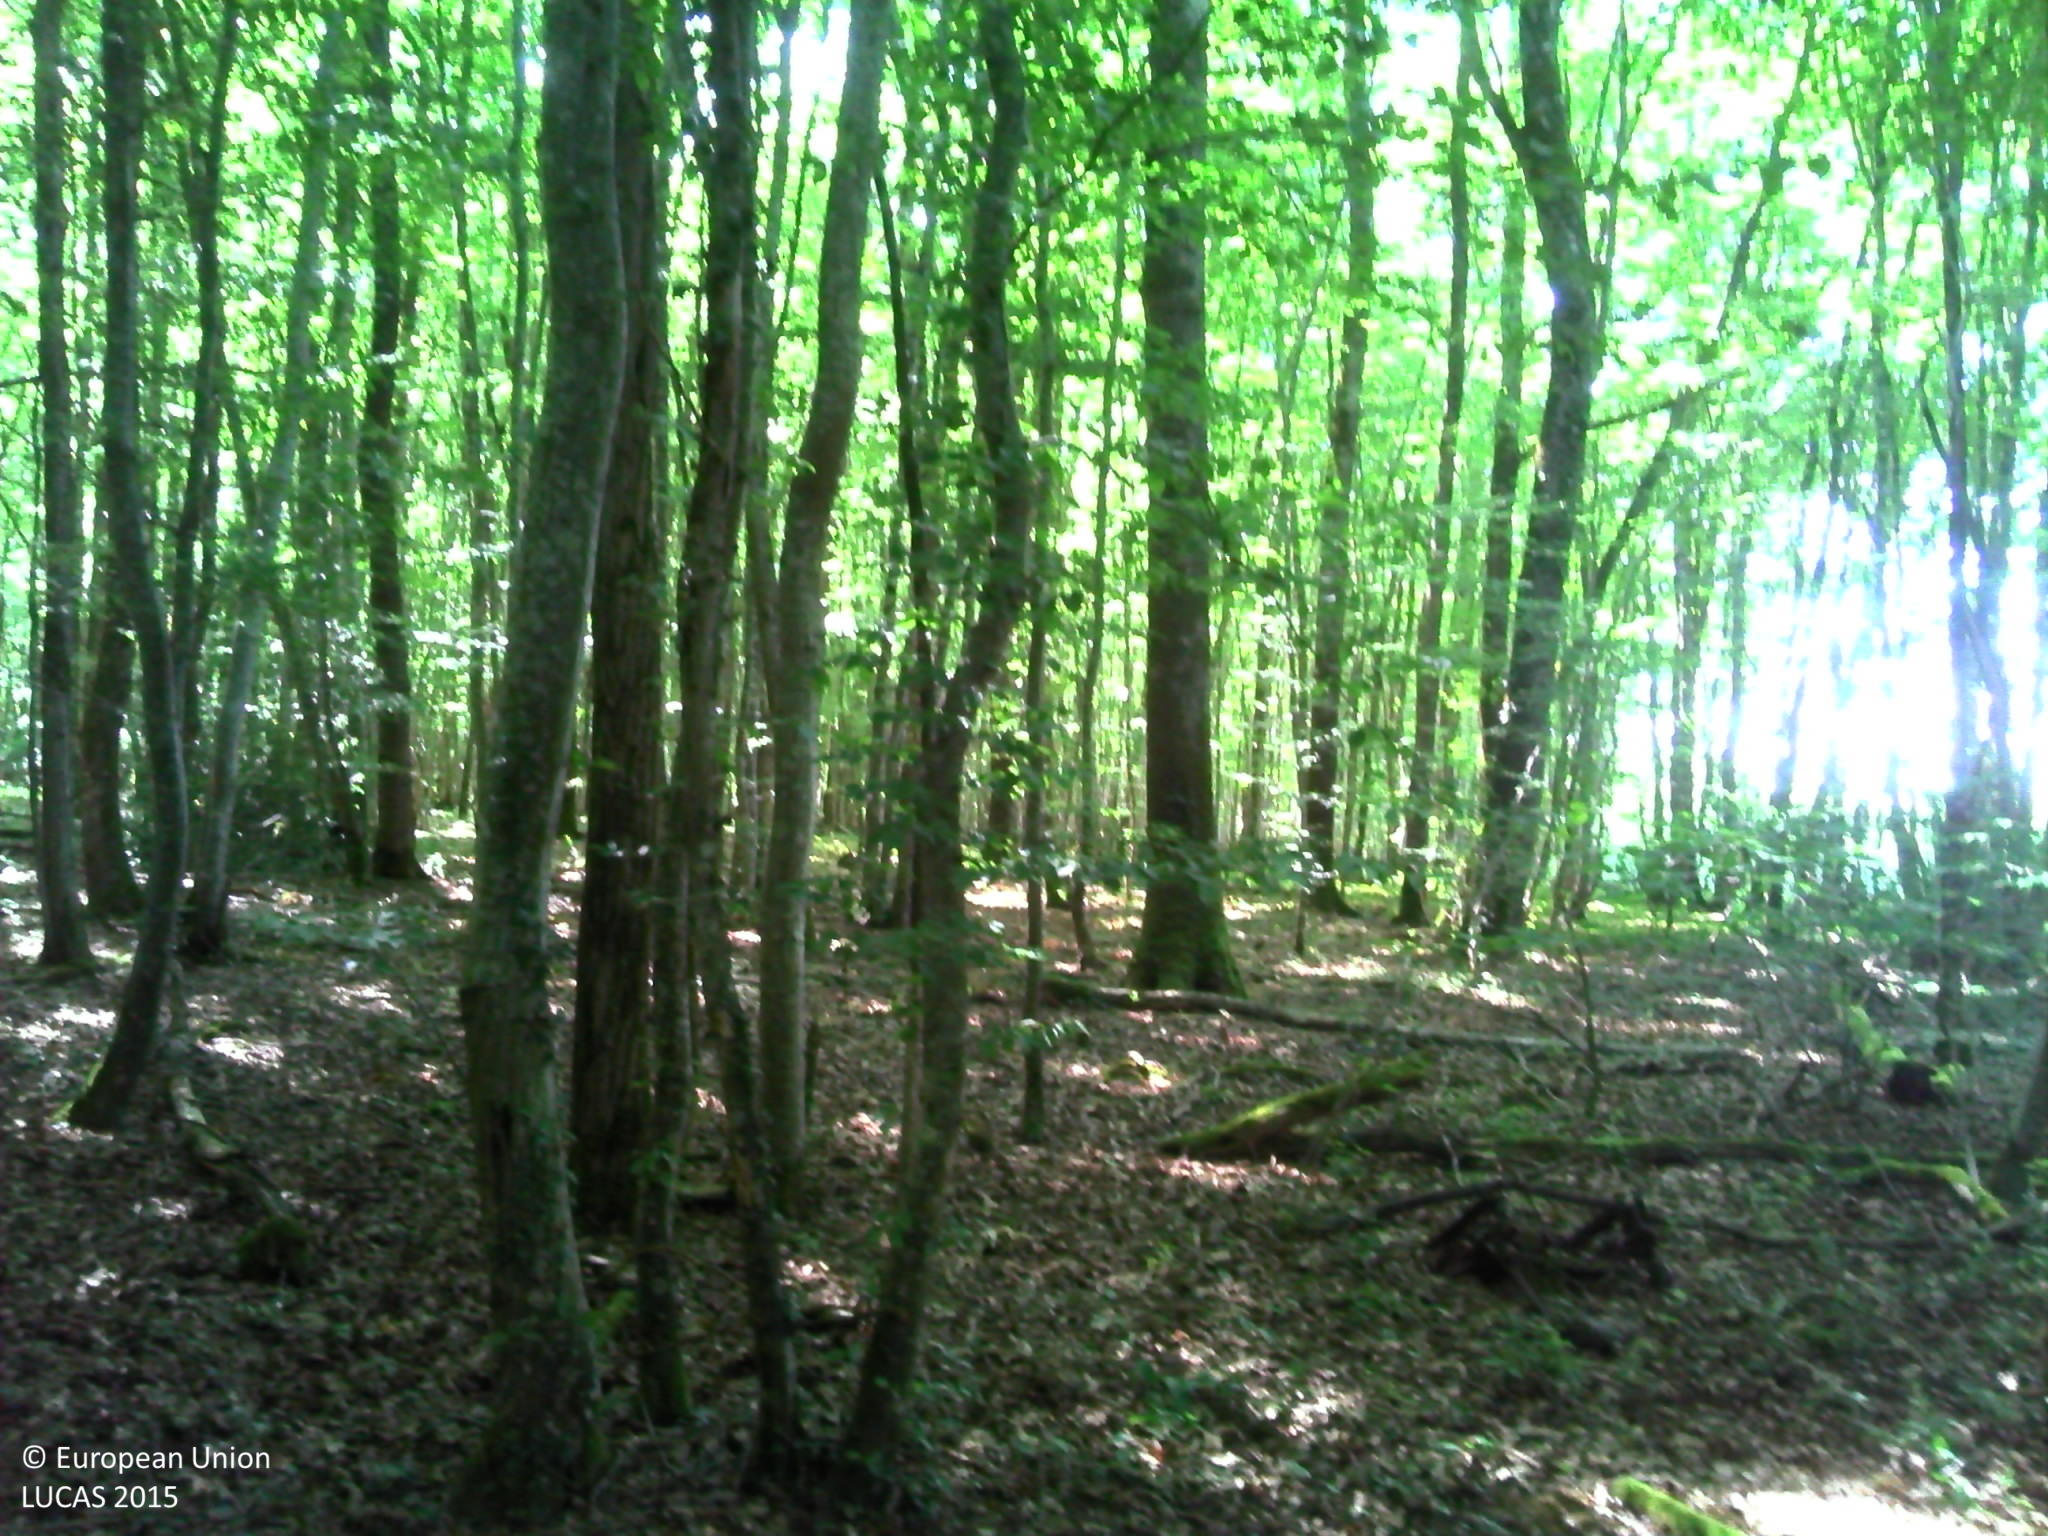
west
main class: Woodland
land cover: Broadleaved woodland
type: mesophytic deciduous forest
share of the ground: > 75 %
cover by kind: broadleaved forest trees 100 %
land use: Forestry
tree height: > 5 m
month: June
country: FR
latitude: 47.4904
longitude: 3.5058
